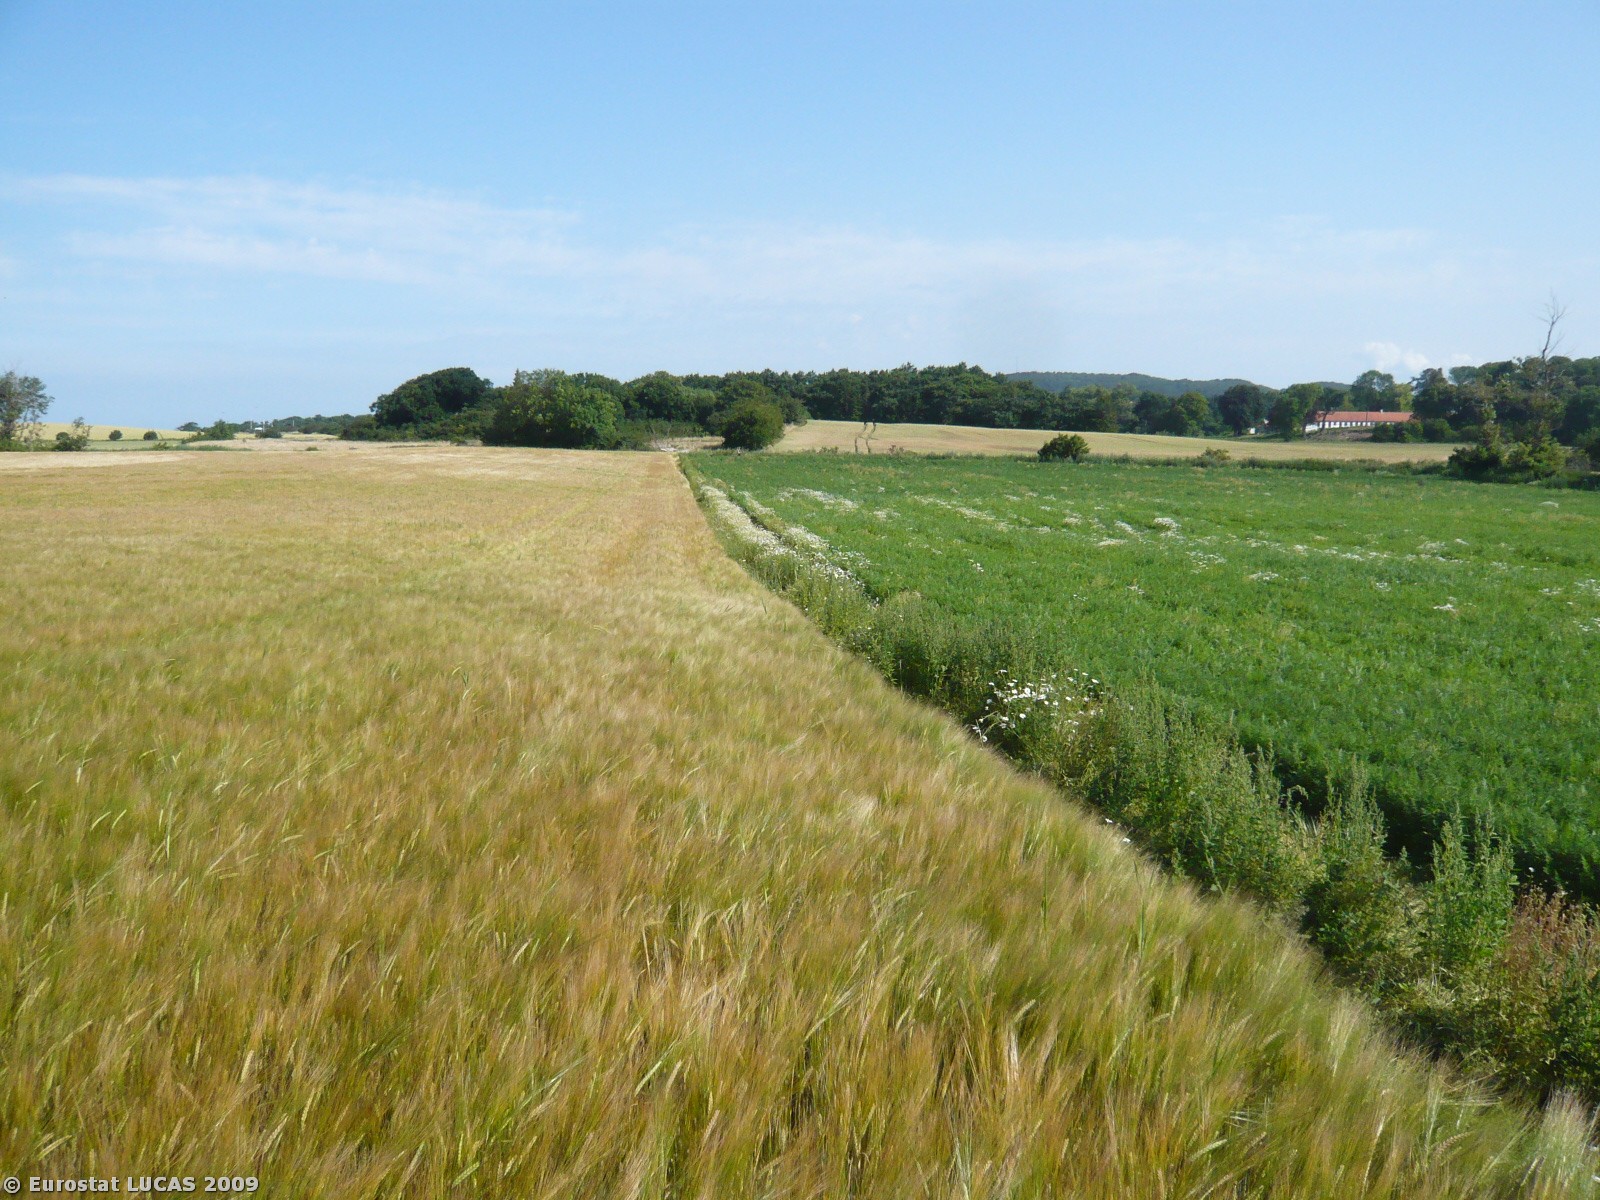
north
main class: Cropland
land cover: Barley
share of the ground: > 75 %
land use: Agriculture (excluding fallow land and kitchen gardens)
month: July
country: DK
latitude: 55.7668
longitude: 11.3853
